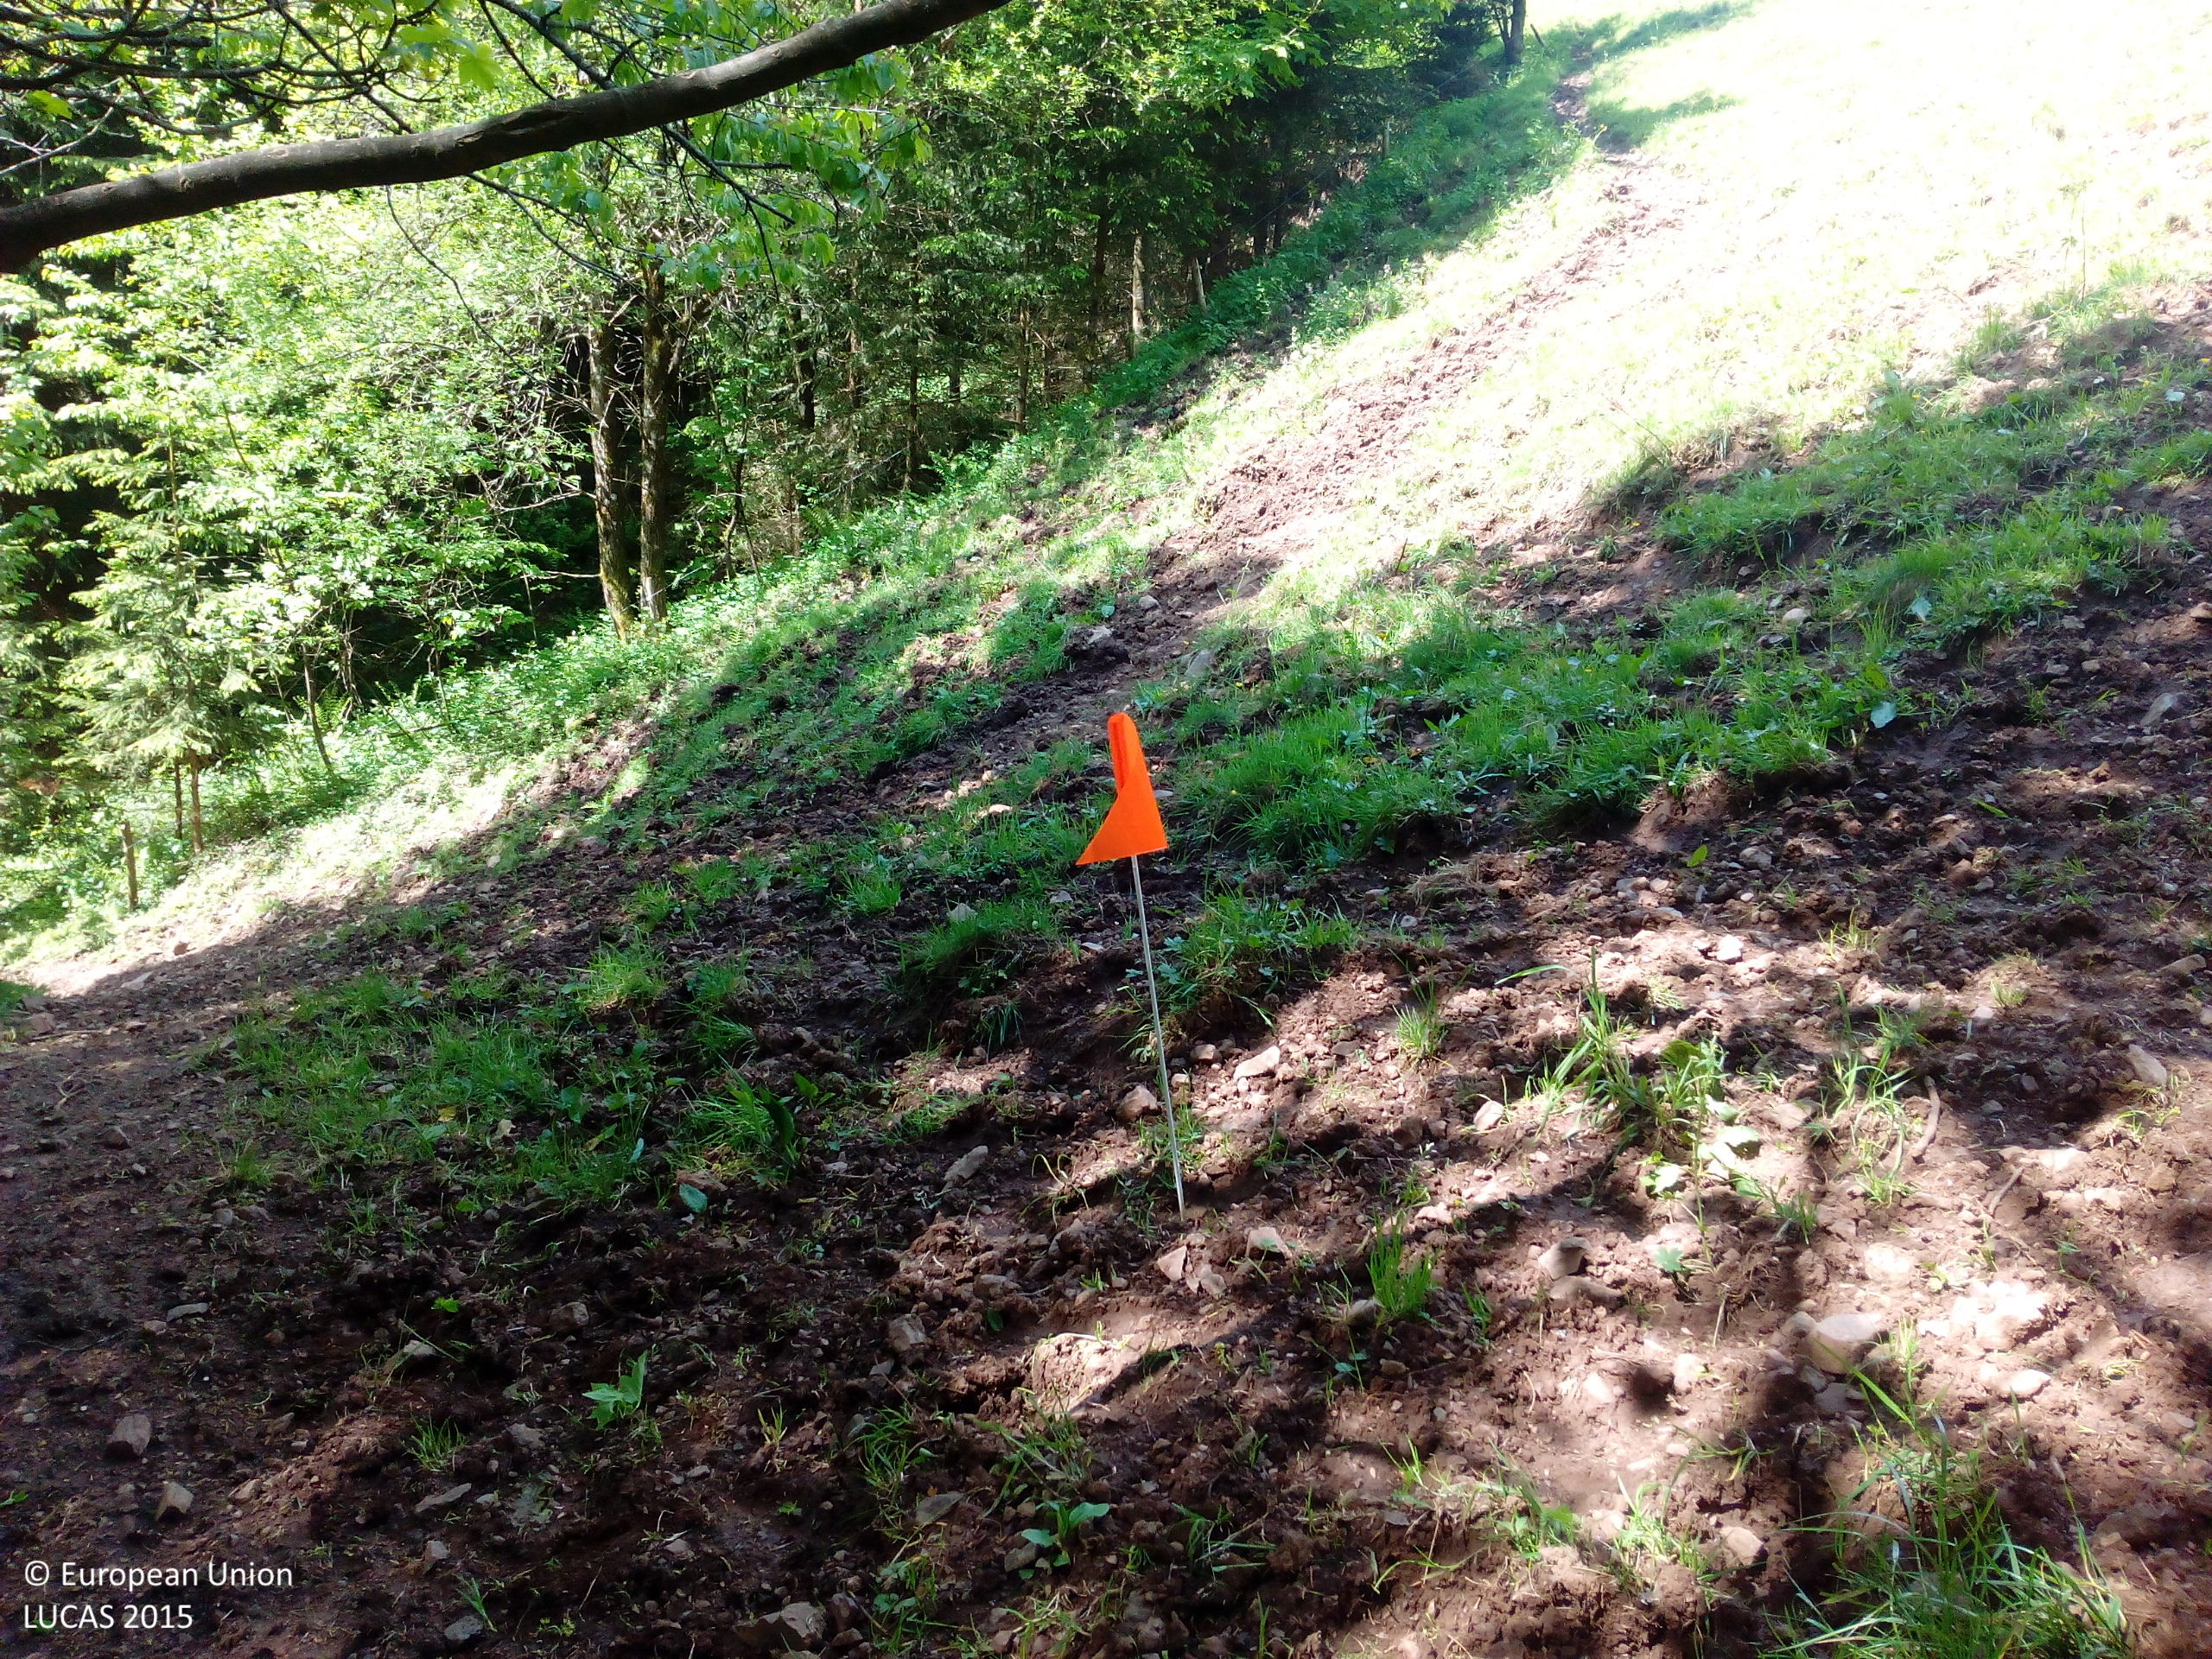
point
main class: Grassland
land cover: Grassland without tree/shrub cover
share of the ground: 25 - 50 %
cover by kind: unconsolidated bare surface 55 %, herbaceous plants 45 %
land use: Agriculture (excluding fallow land and kitchen gardens)
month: May
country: DE
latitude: 48.0094
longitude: 8.1110
